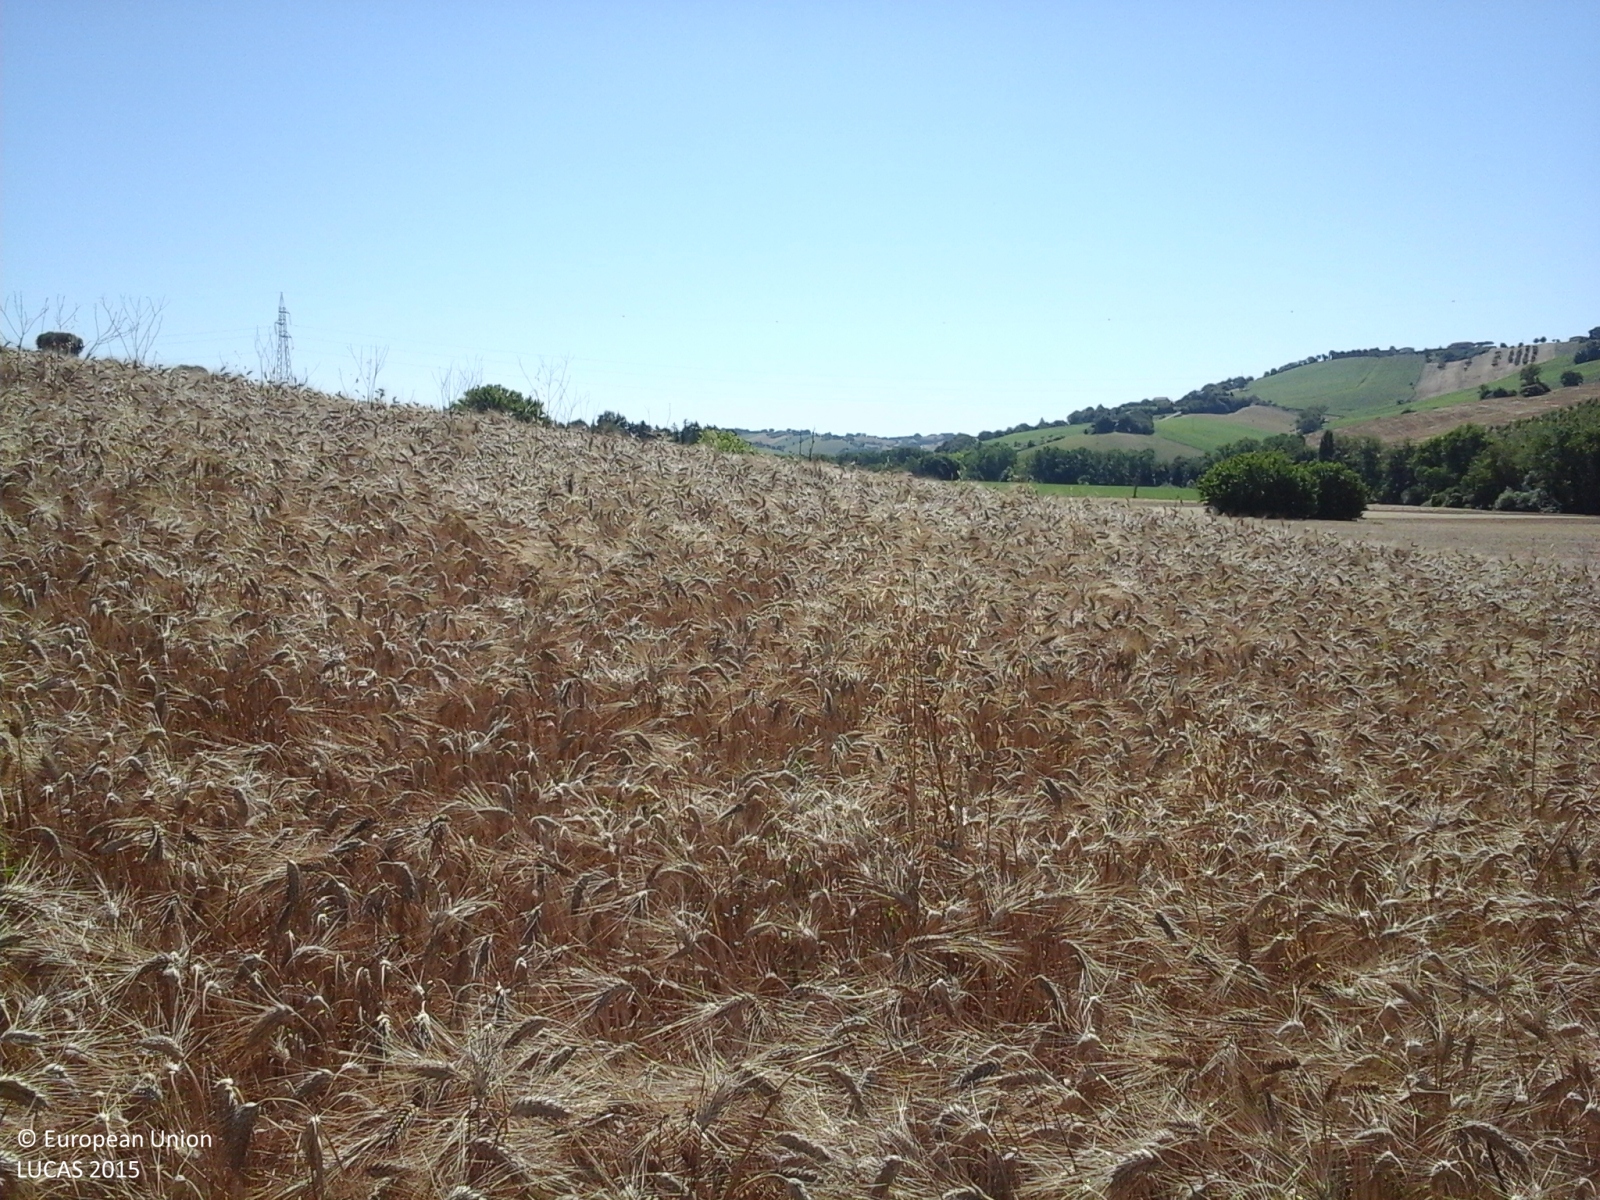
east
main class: Cropland
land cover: Durum wheat
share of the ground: > 75 %
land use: Agriculture (excluding fallow land and kitchen gardens)
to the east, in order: Durum wheat
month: June
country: IT
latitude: 43.3916
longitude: 13.4111
